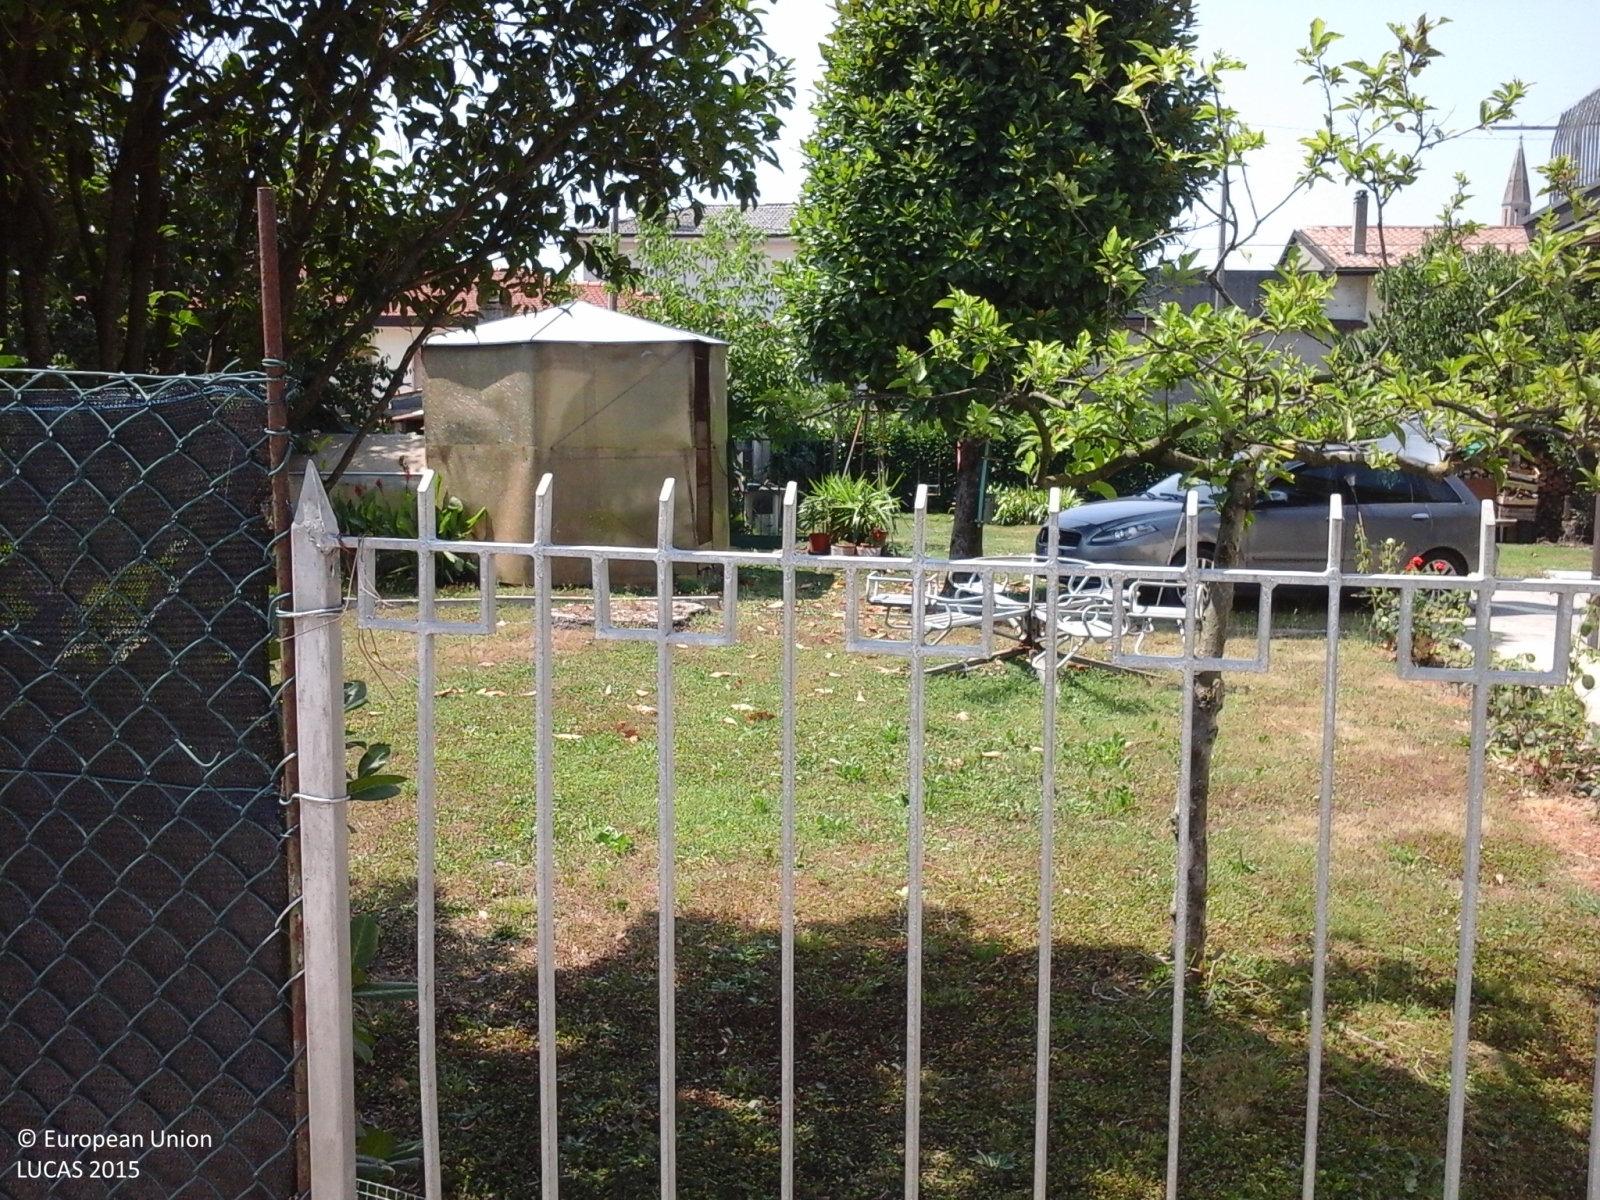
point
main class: Woodland
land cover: Broadleaved woodland
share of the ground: > 75 %
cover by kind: broadleaved forest trees 80 %, herbaceous plants 20 %
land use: Residential
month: July
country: IT
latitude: 45.8606
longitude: 12.1737
